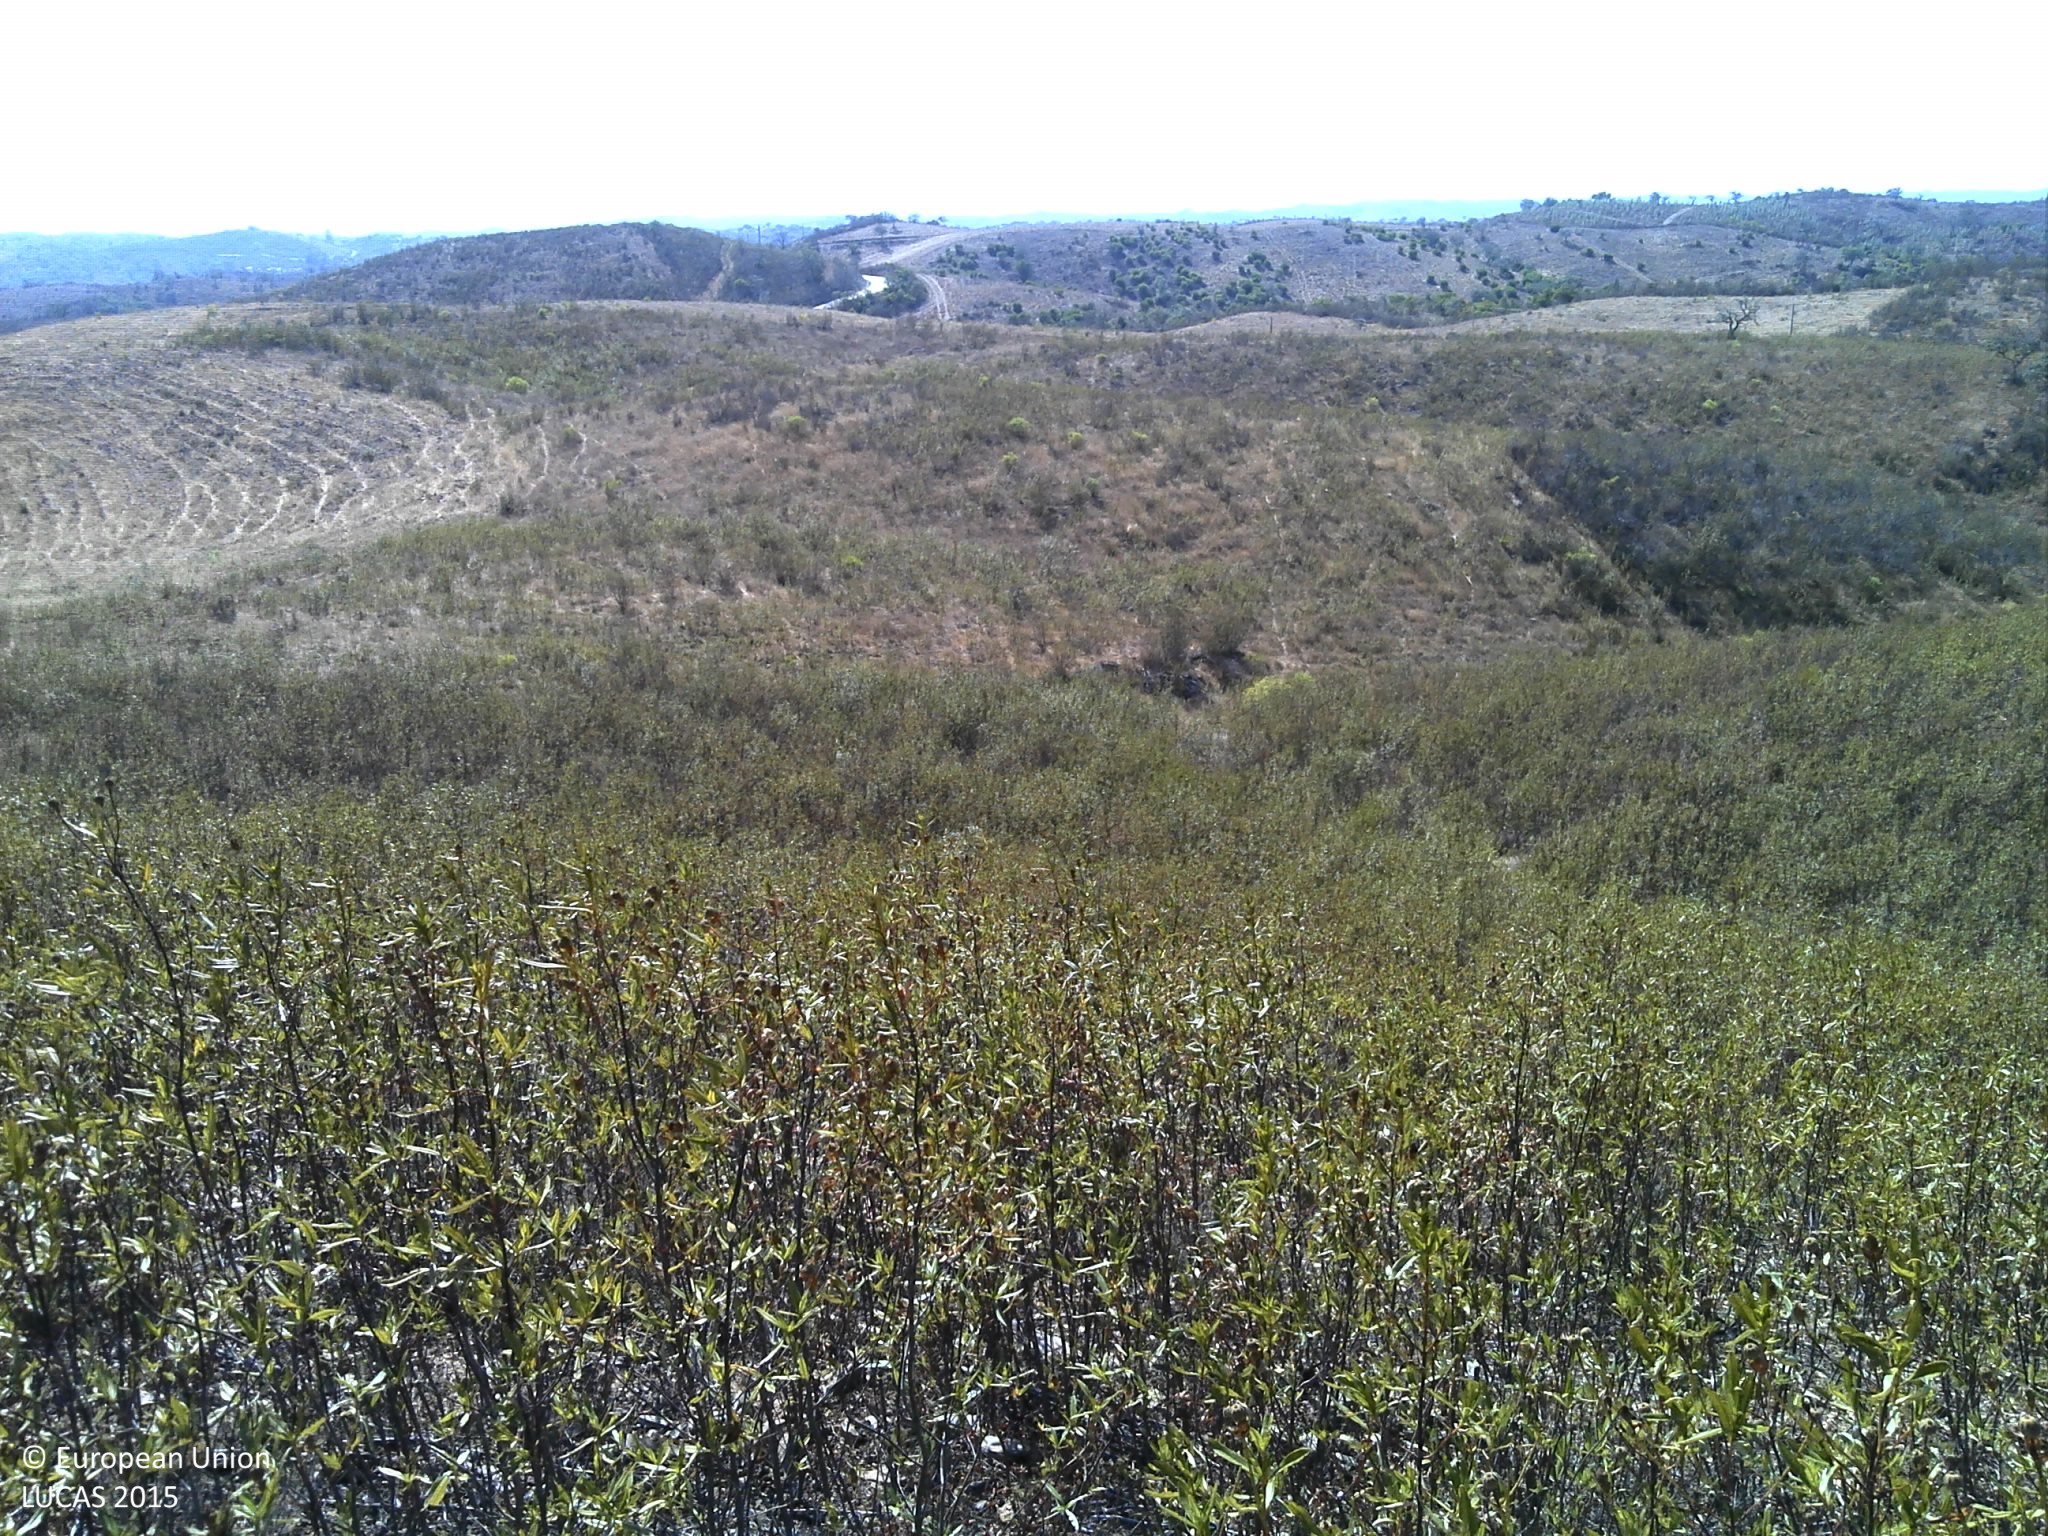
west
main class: Shrubland
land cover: Shrubland without tree cover
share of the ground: 25 - 50 %
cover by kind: unconsolidated bare surface 55 %, shrubs 45 %
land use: Abandoned areas
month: September
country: PT
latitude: 37.4586
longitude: -8.1916
